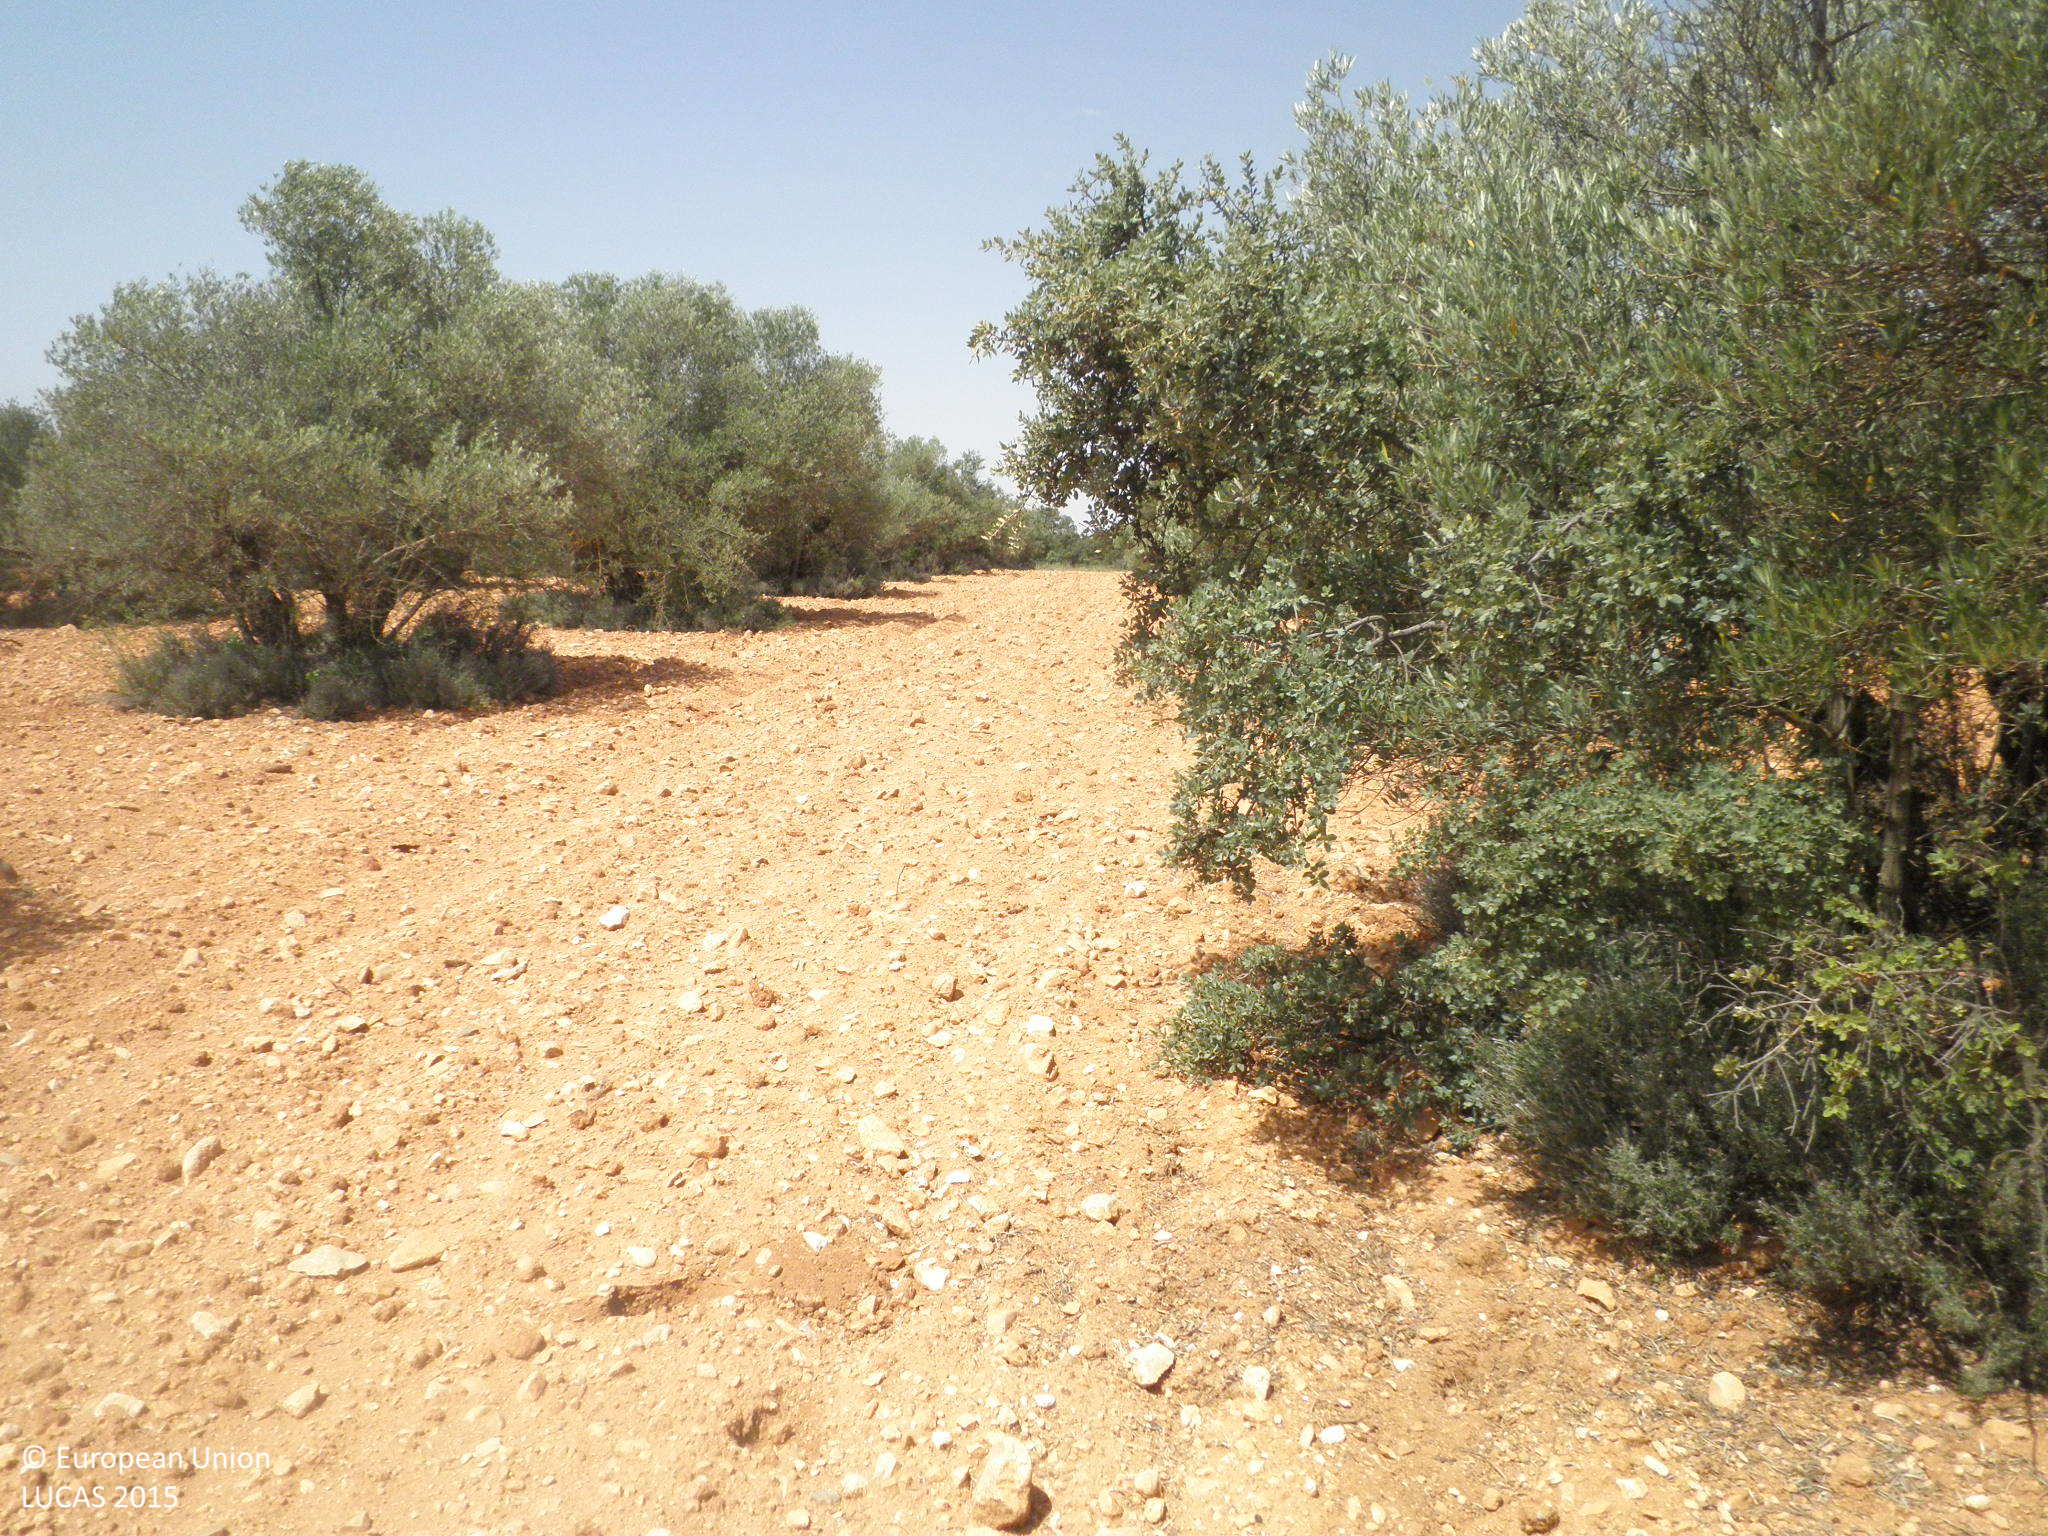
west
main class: Cropland
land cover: Olive groves
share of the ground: 10 - 25 %
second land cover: Other bare soil
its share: > 75 %
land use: Agriculture (excluding fallow land and kitchen gardens)
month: July
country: ES
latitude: 39.5945
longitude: -2.6257
